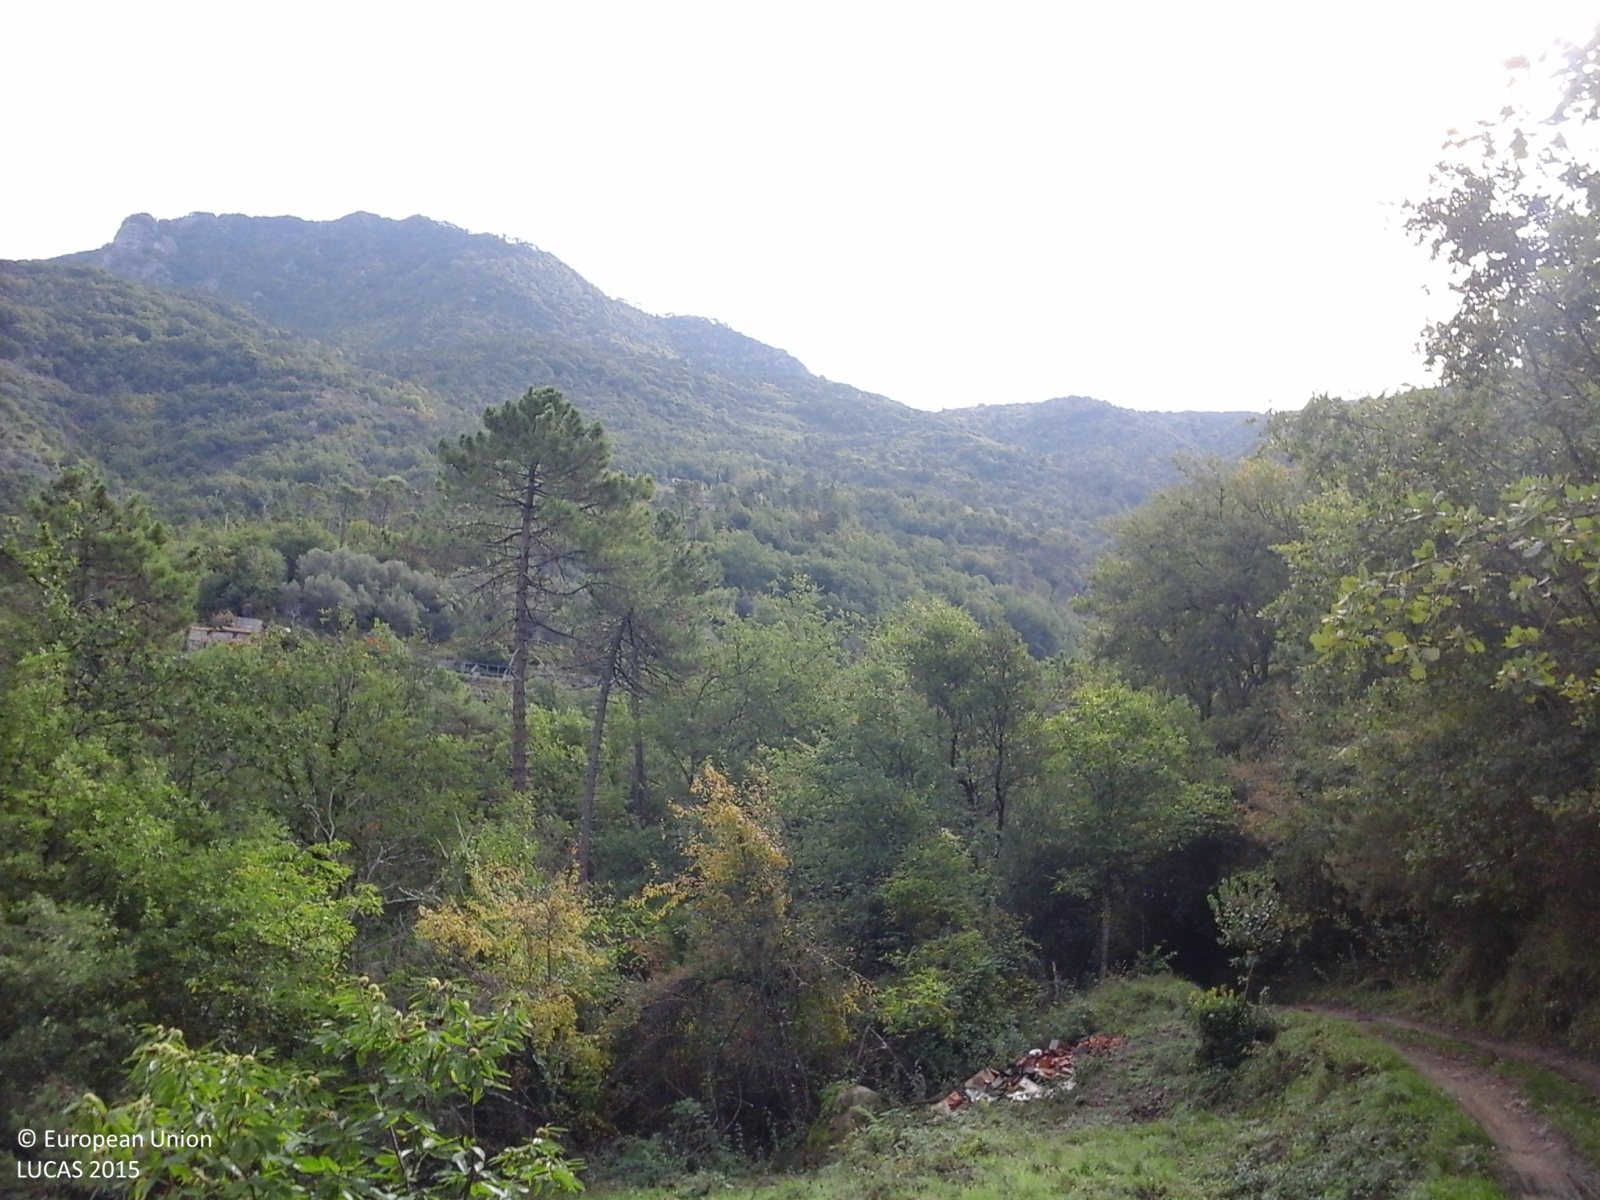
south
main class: Woodland
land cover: Other mixed woodland
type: thermophilous deciduous forest
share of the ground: > 75 %
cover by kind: broadleaved forest trees 50 %, coniferous forest trees 30 %, shrubs 10 %, herbaceous plants 10 %
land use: Semi-natural and natural areas not in use
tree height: > 5 m
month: October
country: IT
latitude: 43.8740
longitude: 7.7033
